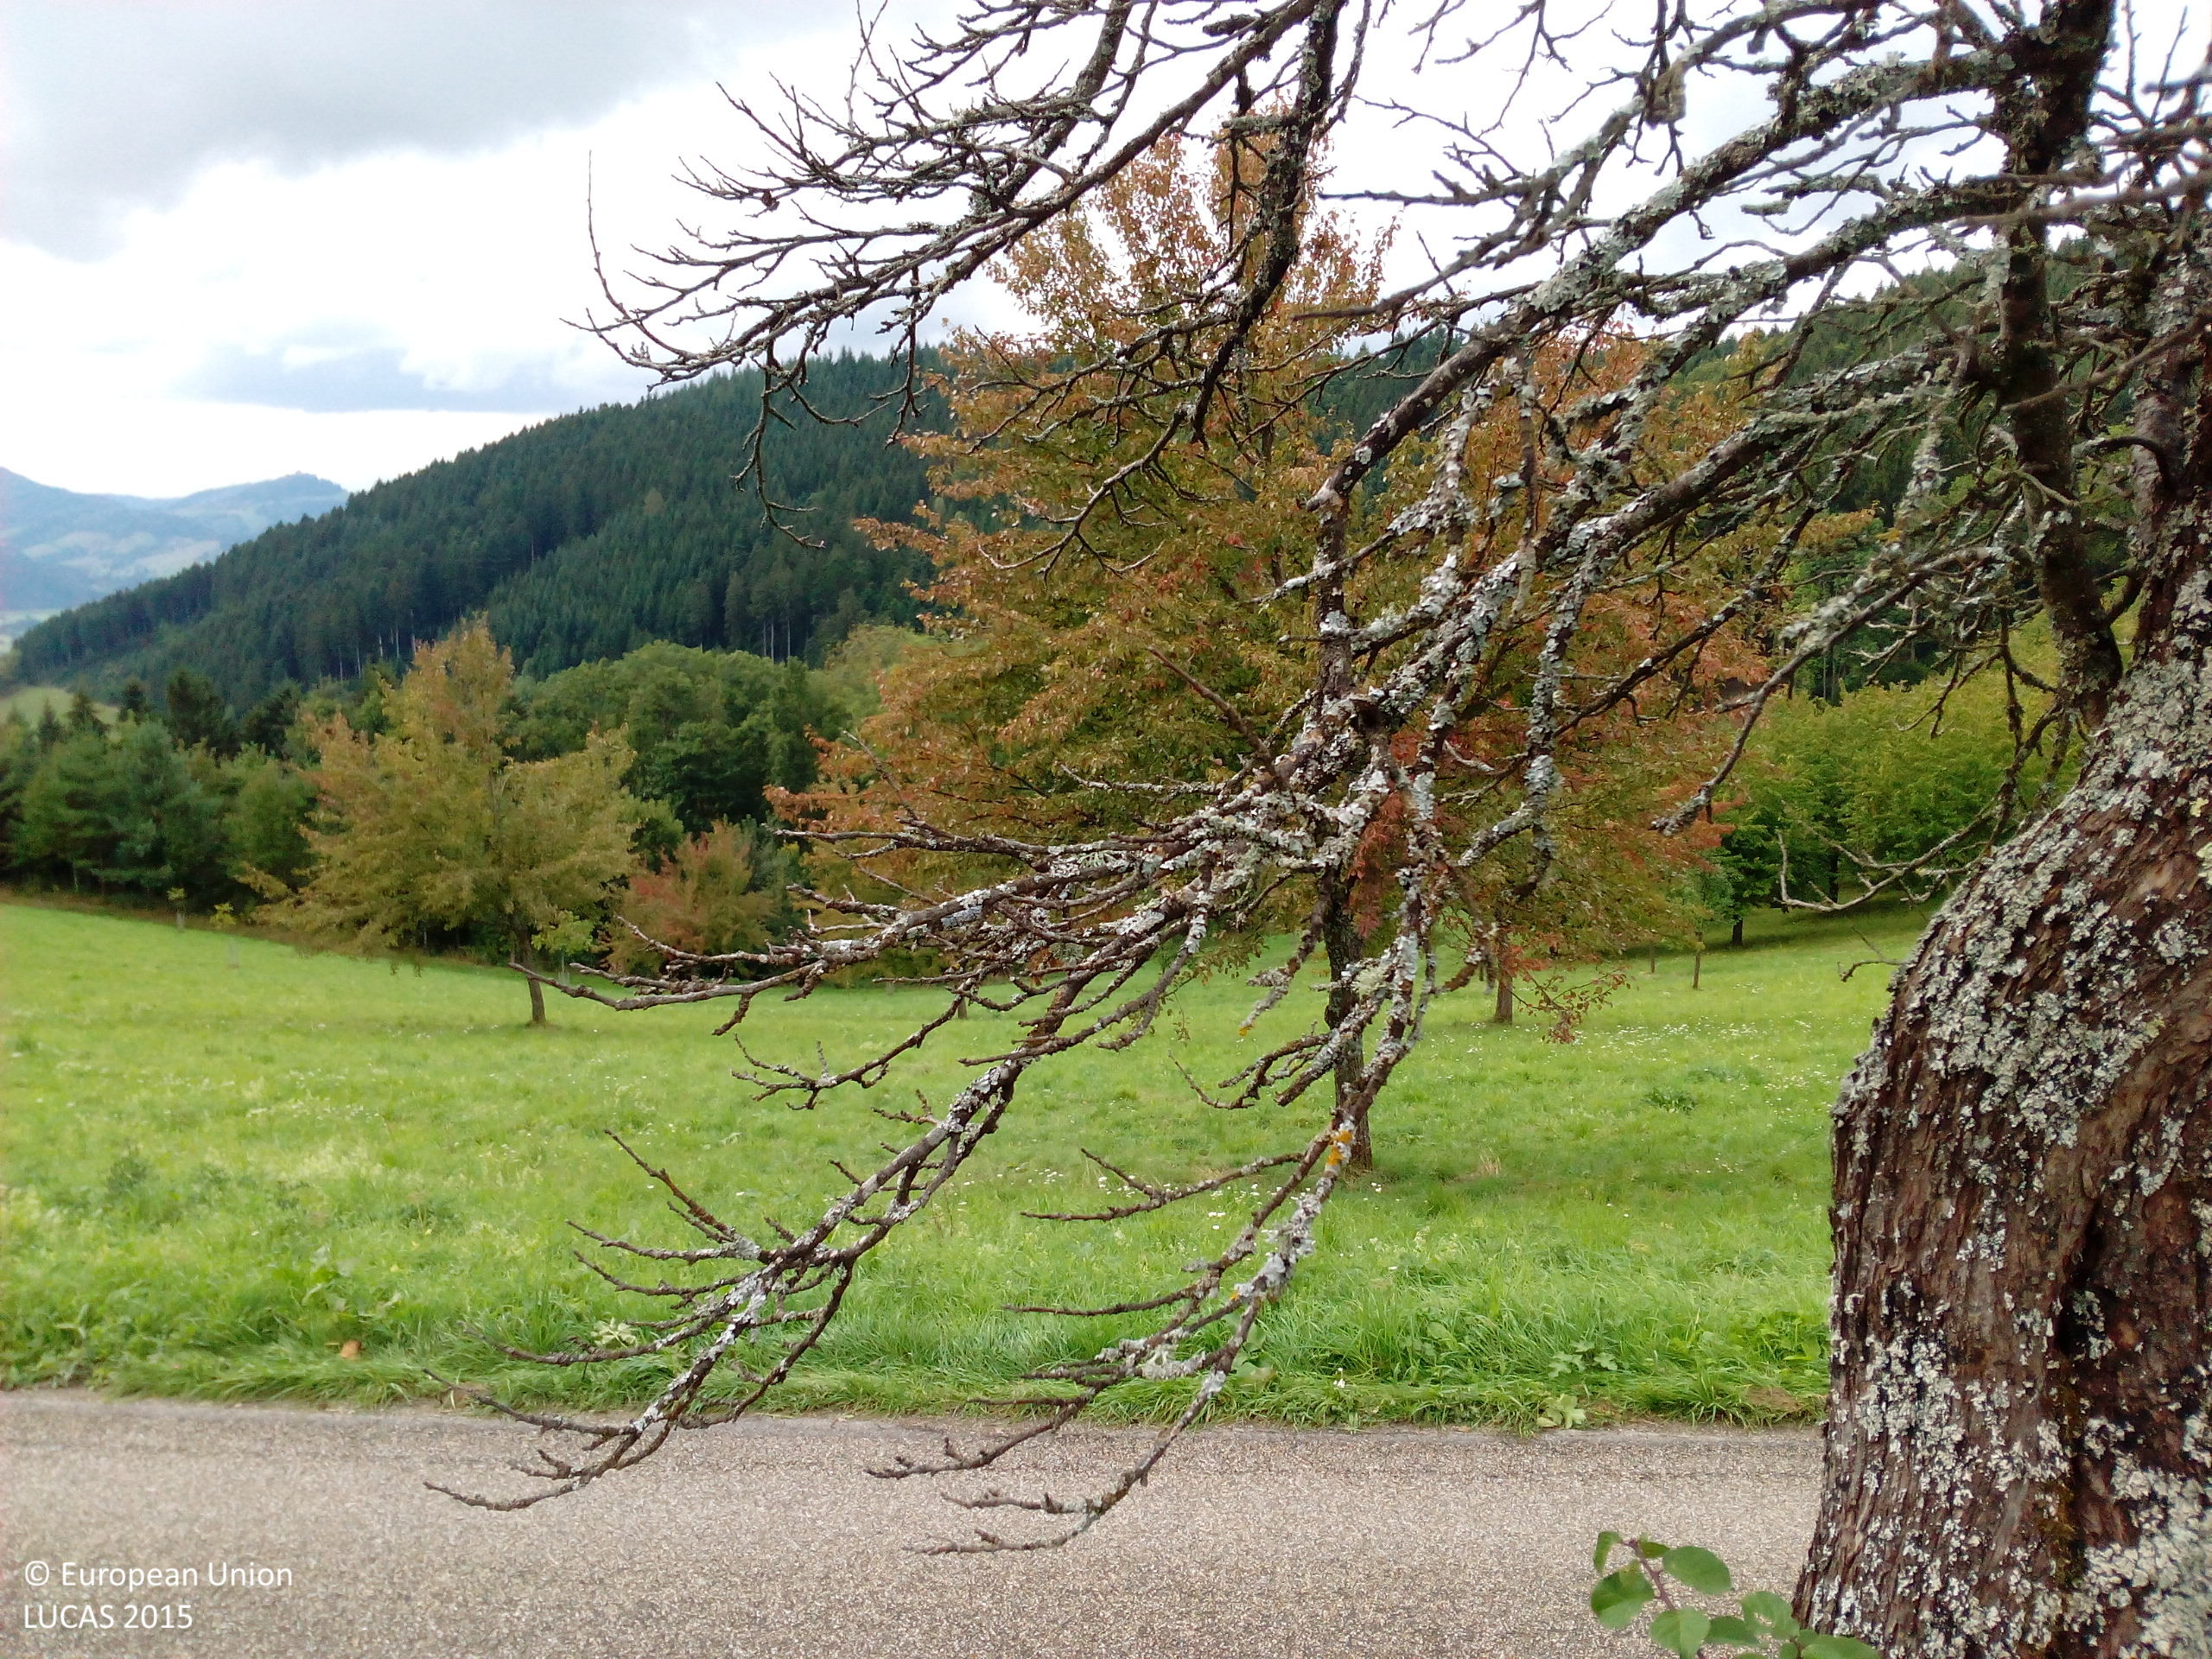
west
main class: Cropland
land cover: Other fruit trees and berries
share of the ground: 10 - 25 %
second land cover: Grassland without tree/shrub cover
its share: > 75 %
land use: Agriculture (excluding fallow land and kitchen gardens)
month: September
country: DE
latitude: 48.3332
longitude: 8.0989
